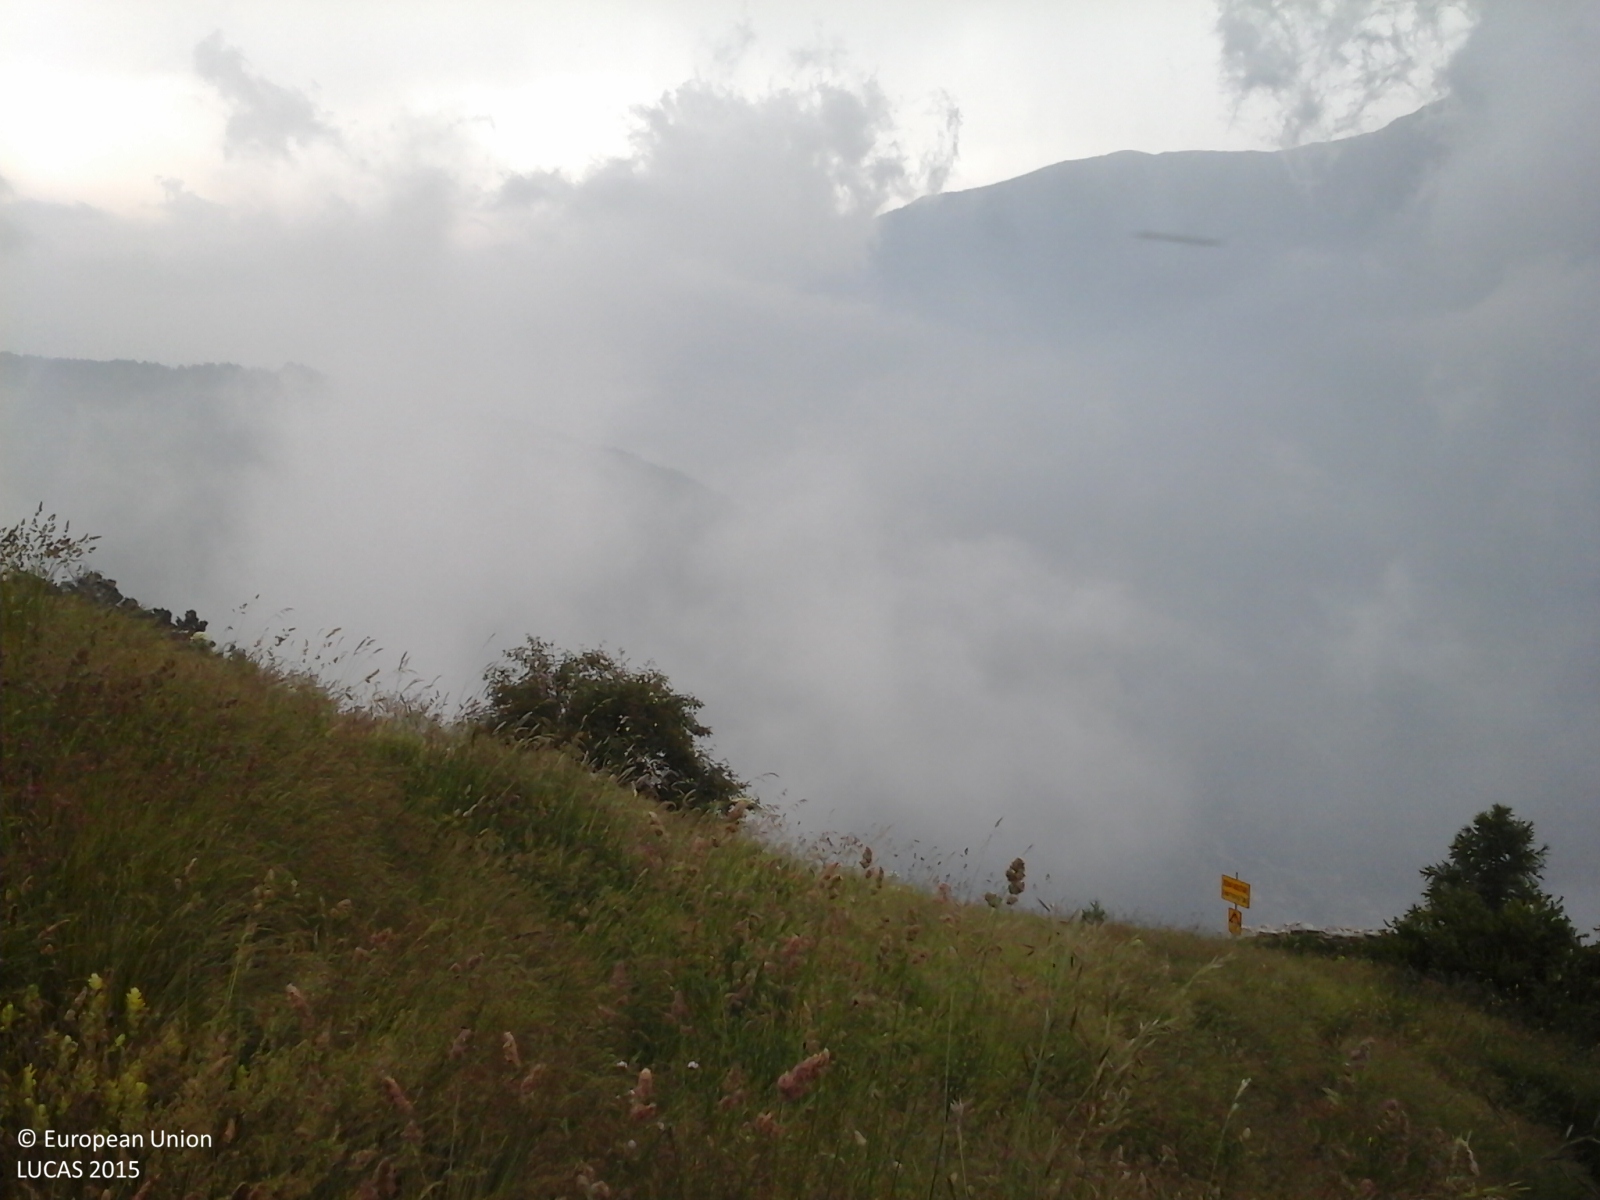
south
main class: Grassland
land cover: Grassland with sparse tree/shrub cover
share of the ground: > 75 %
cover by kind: herbaceous plants 95 %, coniferous forest trees 5 %
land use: Semi-natural and natural areas not in use
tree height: > 5 m
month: July
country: IT
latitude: 45.0483
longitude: 7.0466
